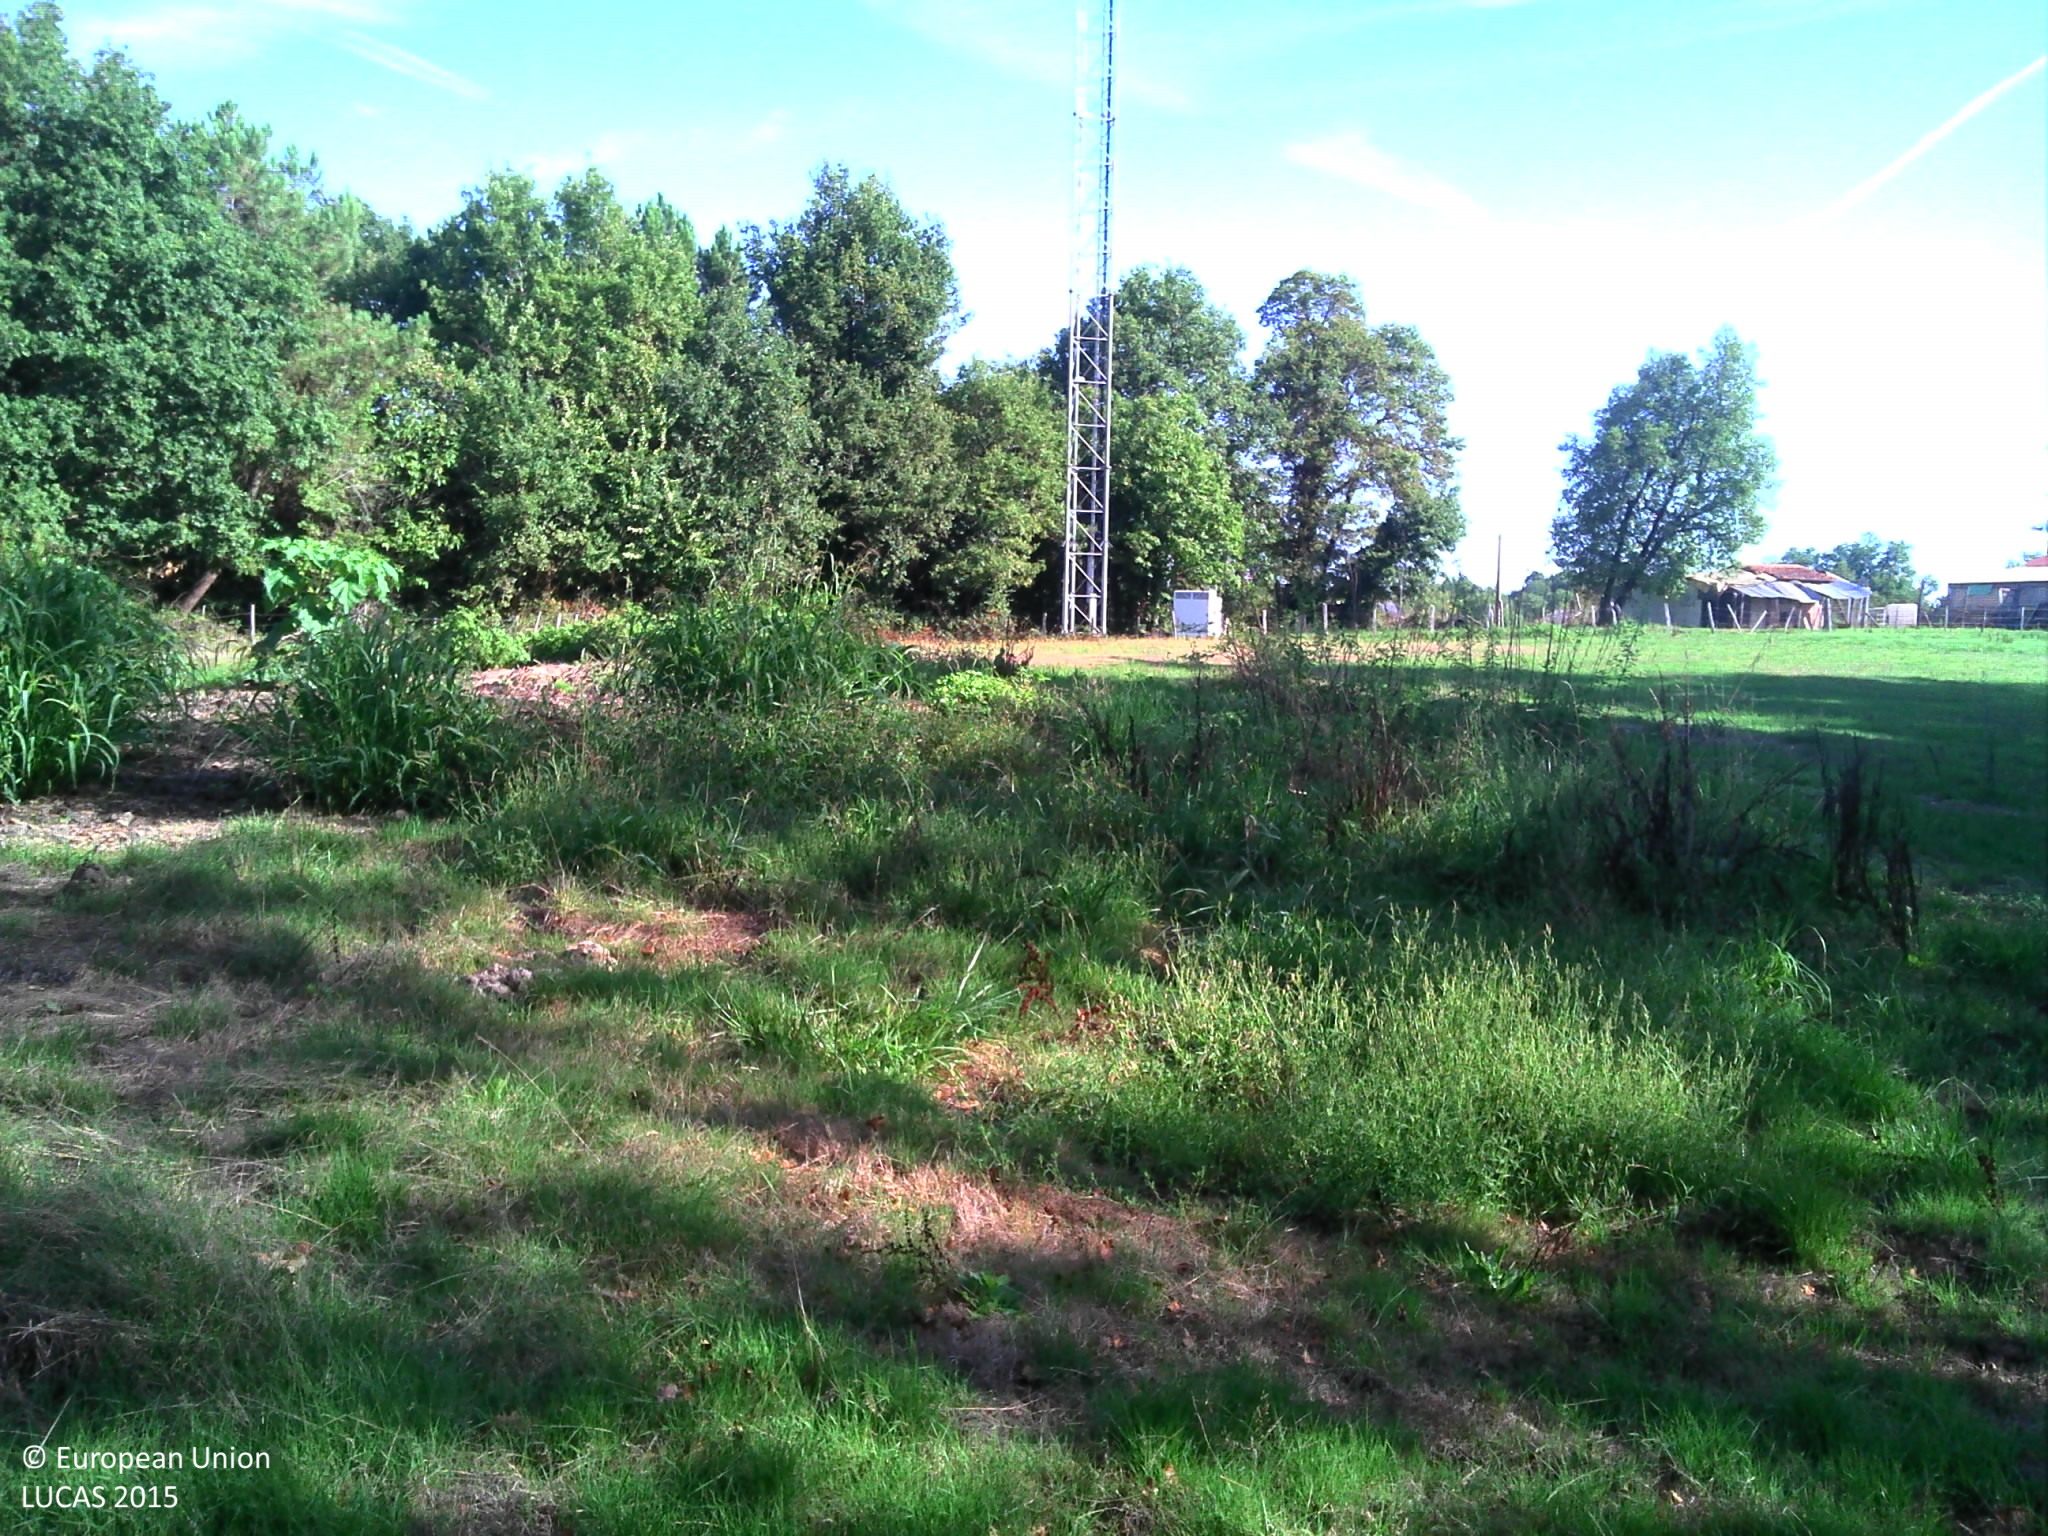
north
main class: Grassland
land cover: Spontaneously vegetated surfaces
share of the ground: > 75 %
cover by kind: herbaceous plants 60 %, unconsolidated bare surface 25 %, lichens and mosses 10 %, shrubs 5 %
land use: Semi-natural and natural areas not in use
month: August
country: FR
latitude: 45.4149
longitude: 0.6475
